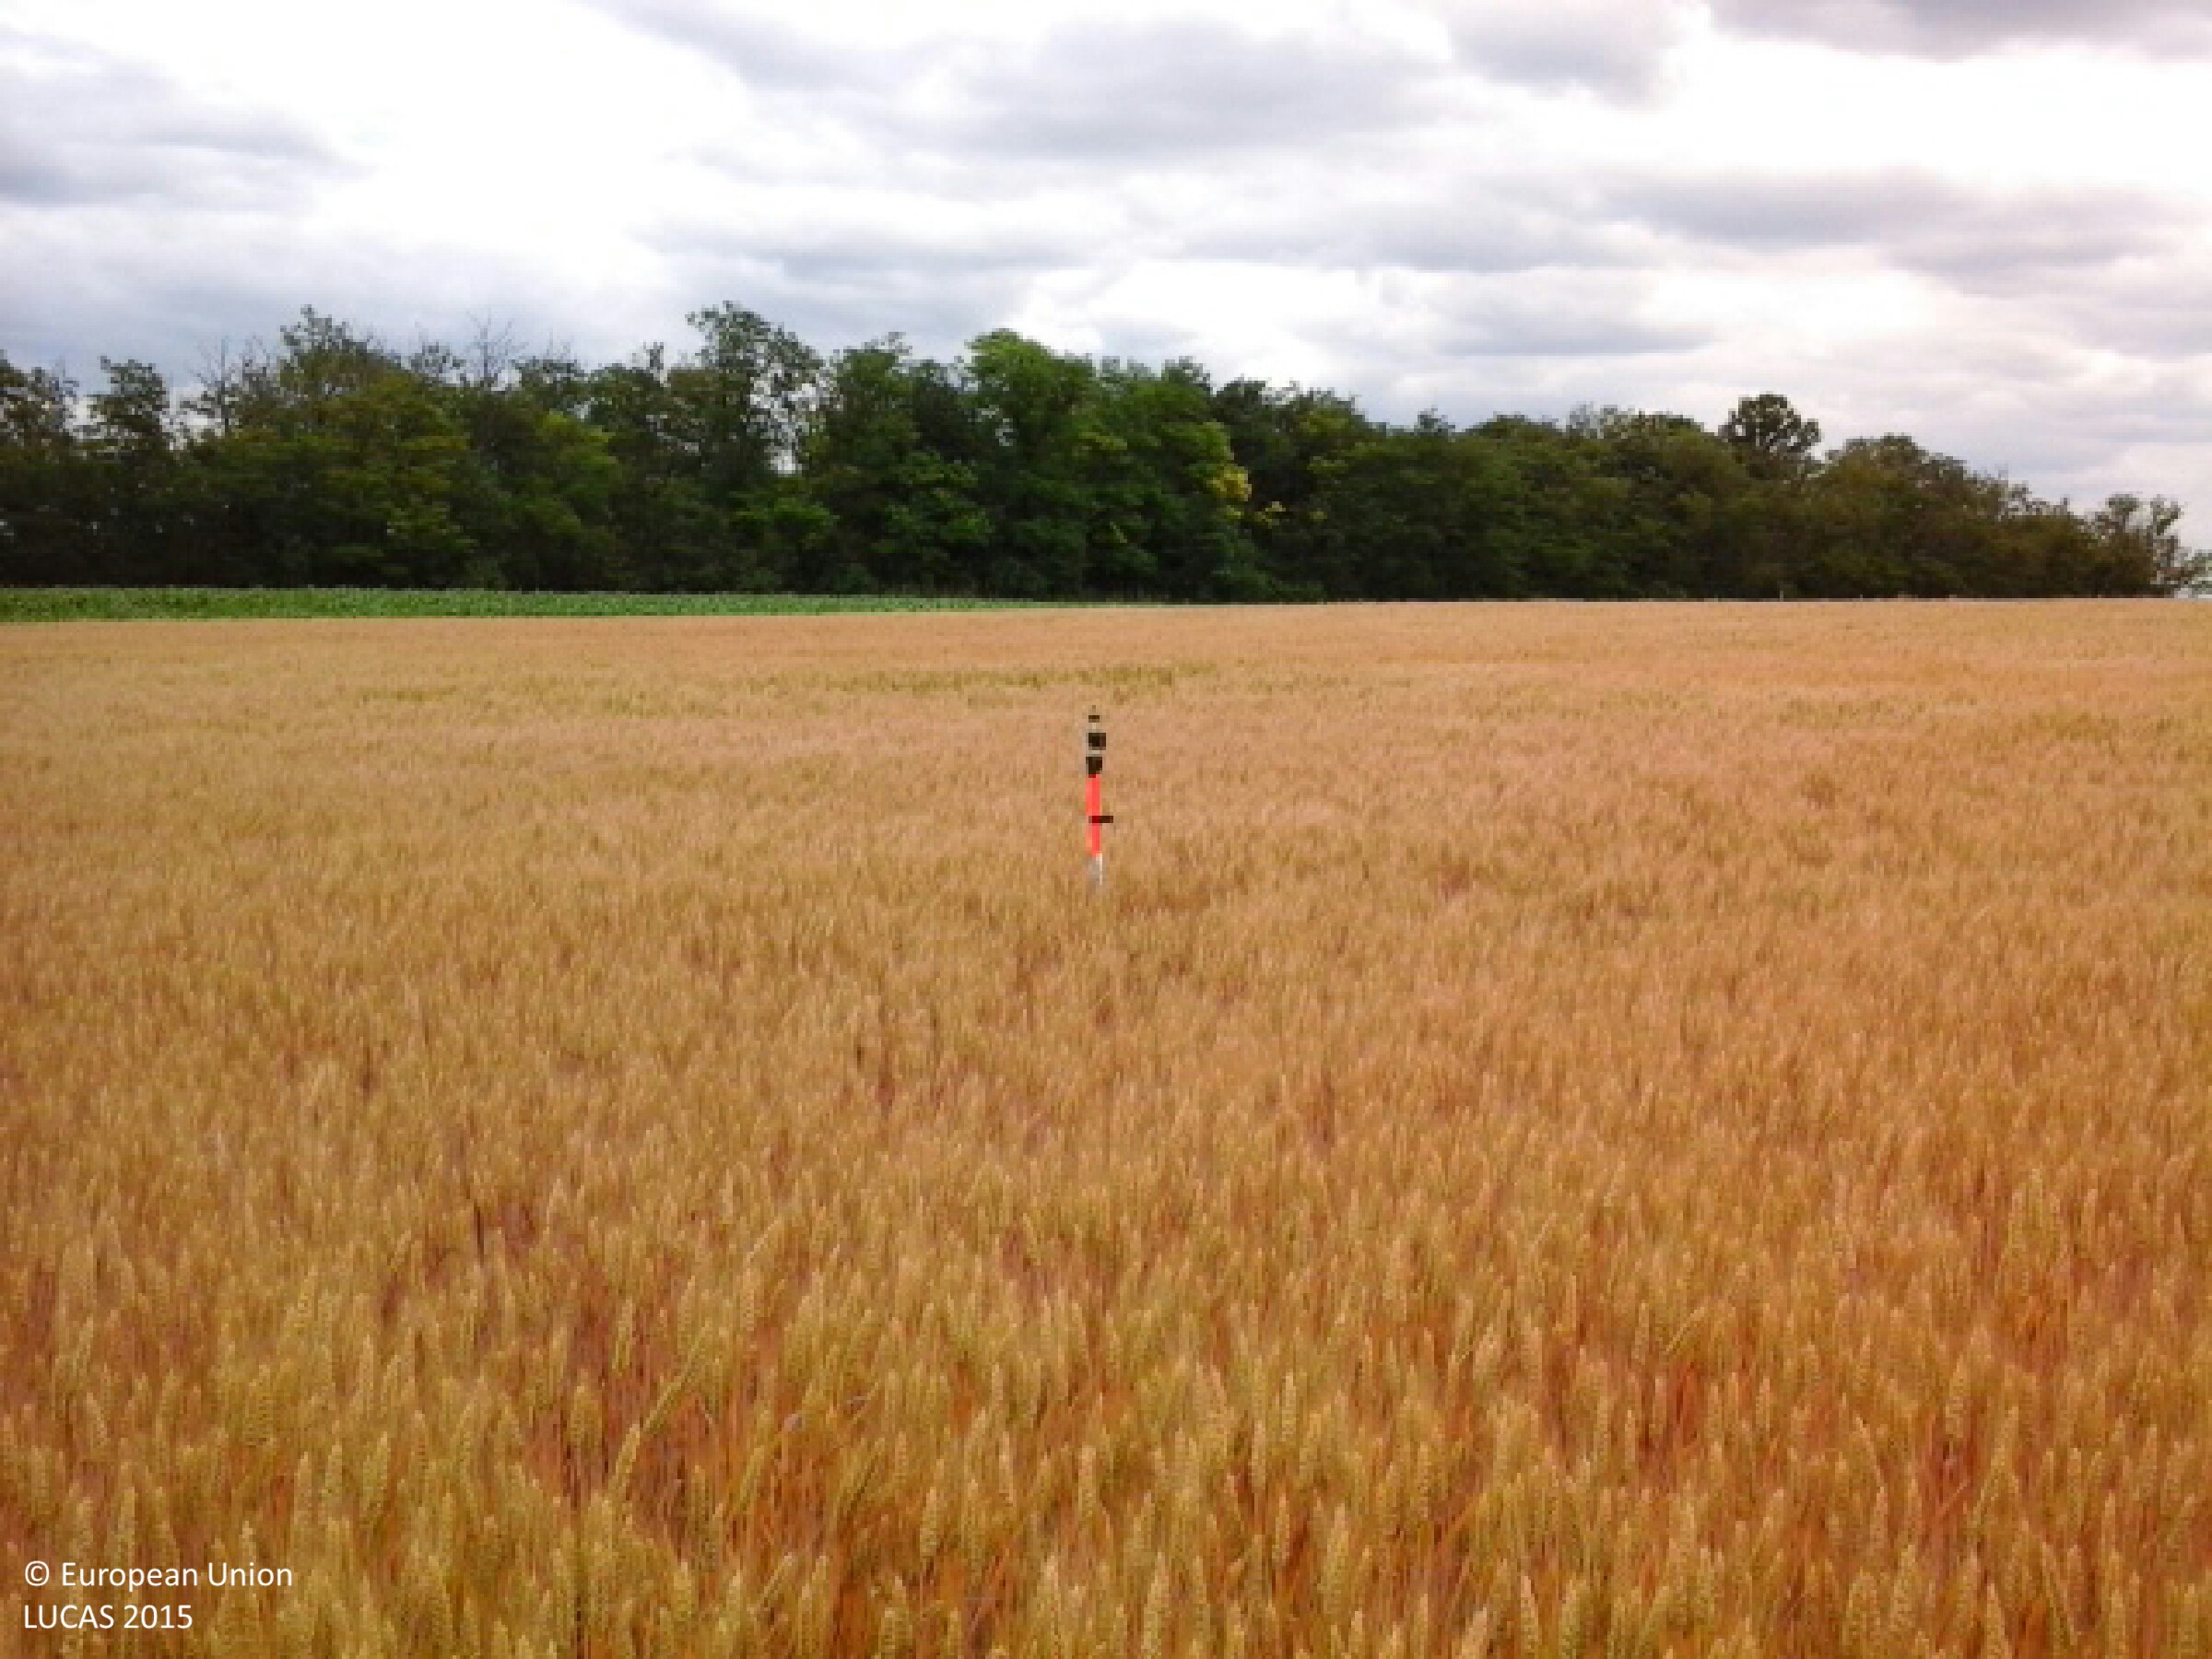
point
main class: Cropland
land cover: Triticale
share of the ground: > 75 %
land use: Agriculture (excluding fallow land and kitchen gardens)
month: June
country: HU
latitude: 47.9353
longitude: 21.4354
